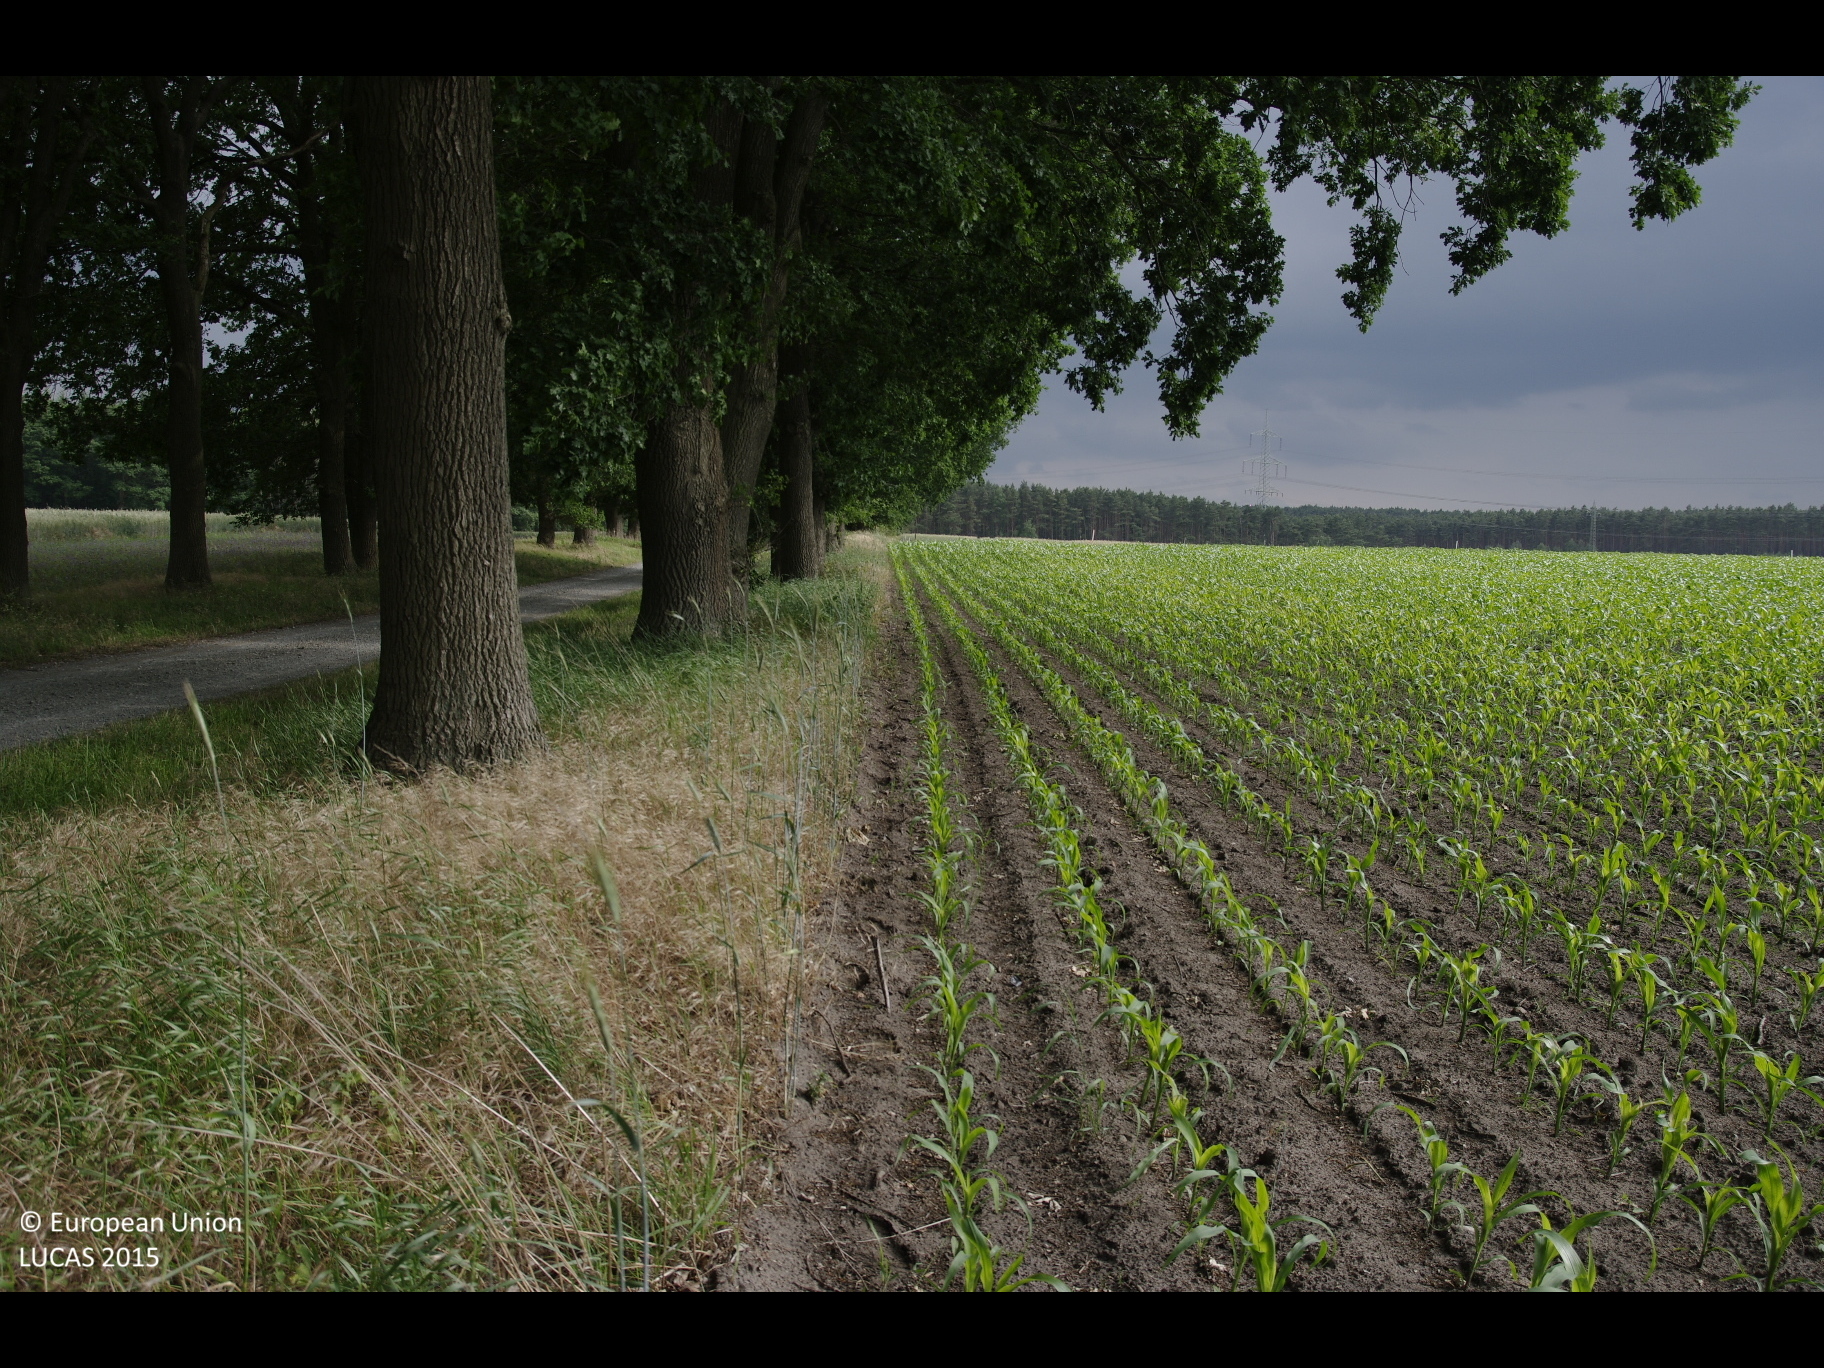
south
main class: Cropland
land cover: Maize
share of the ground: 25 - 50 %
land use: Agriculture (excluding fallow land and kitchen gardens)
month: June
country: DE
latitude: 53.2757
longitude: 10.3148
